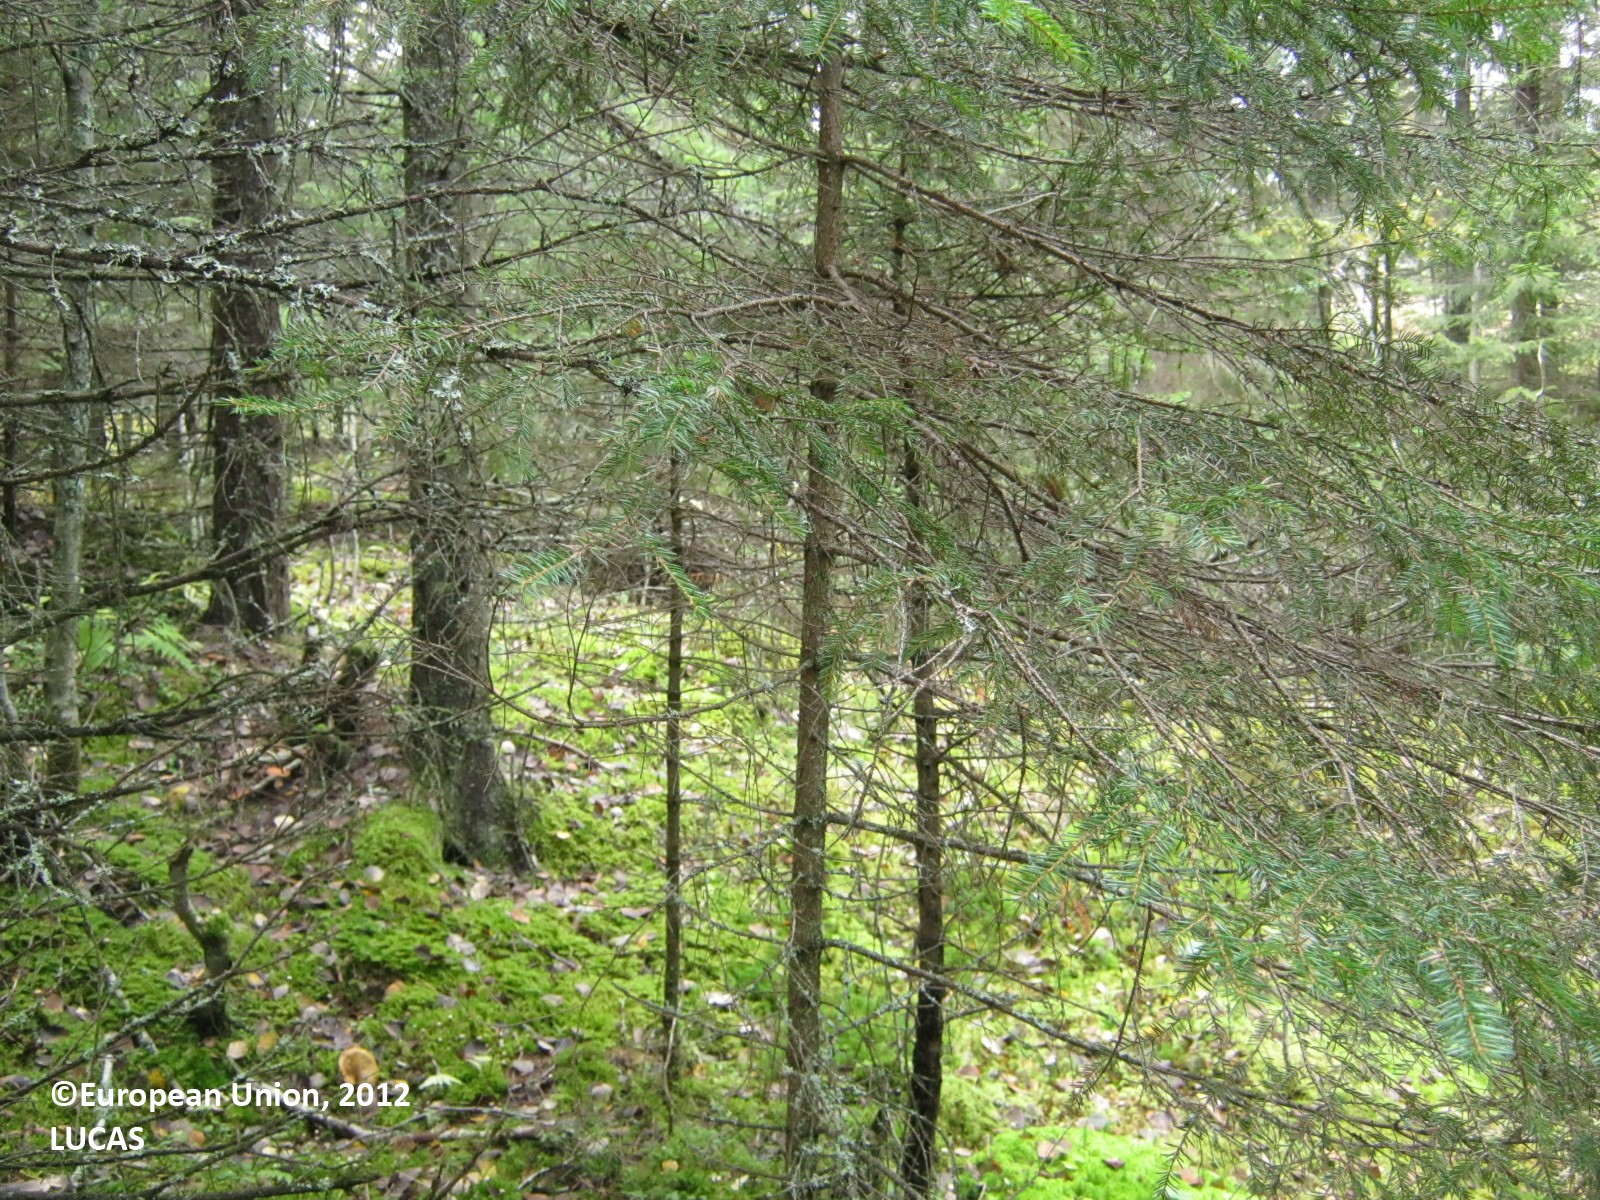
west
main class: Woodland
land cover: Spruce dominated coniferous woodland
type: boreal forest
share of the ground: 50 - 75 %
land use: Forestry
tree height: > 5 m
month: September
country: FI
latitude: 62.5238
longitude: 27.4767
